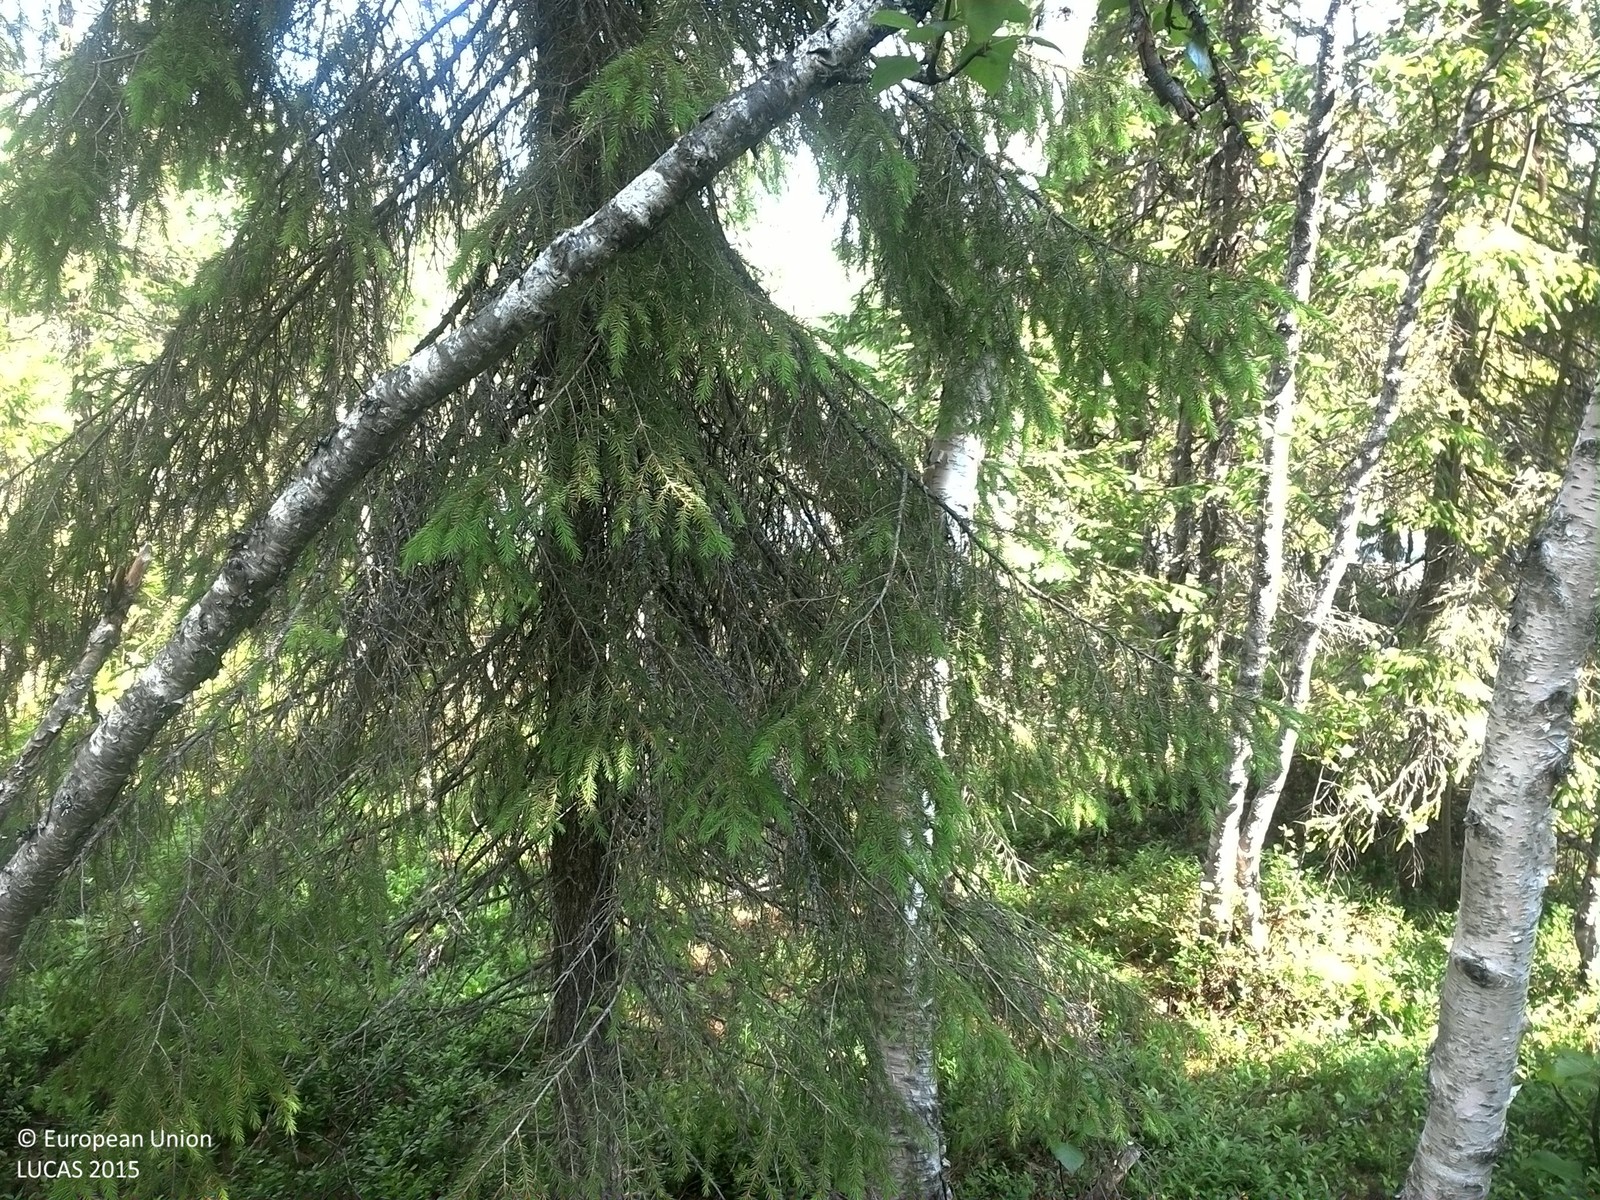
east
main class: Woodland
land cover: Spruce dominated coniferous woodland
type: boreal forest
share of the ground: 50 - 75 %
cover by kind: coniferous forest trees 55 %, shrubs 30 %, broadleaved forest trees 5 %, herbaceous plants 5 %, lichens and mosses 5 %
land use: Forestry
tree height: > 5 m
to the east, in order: Spruce dominated coniferous woodland; Shruby margins; Ditches and canals; Paved roads, cycling and walking lanes; Grass margins; Ditches and canals; Shruby margins; Spruce dominated coniferous woodland
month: July
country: SE
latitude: 64.7274
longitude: 15.7831
